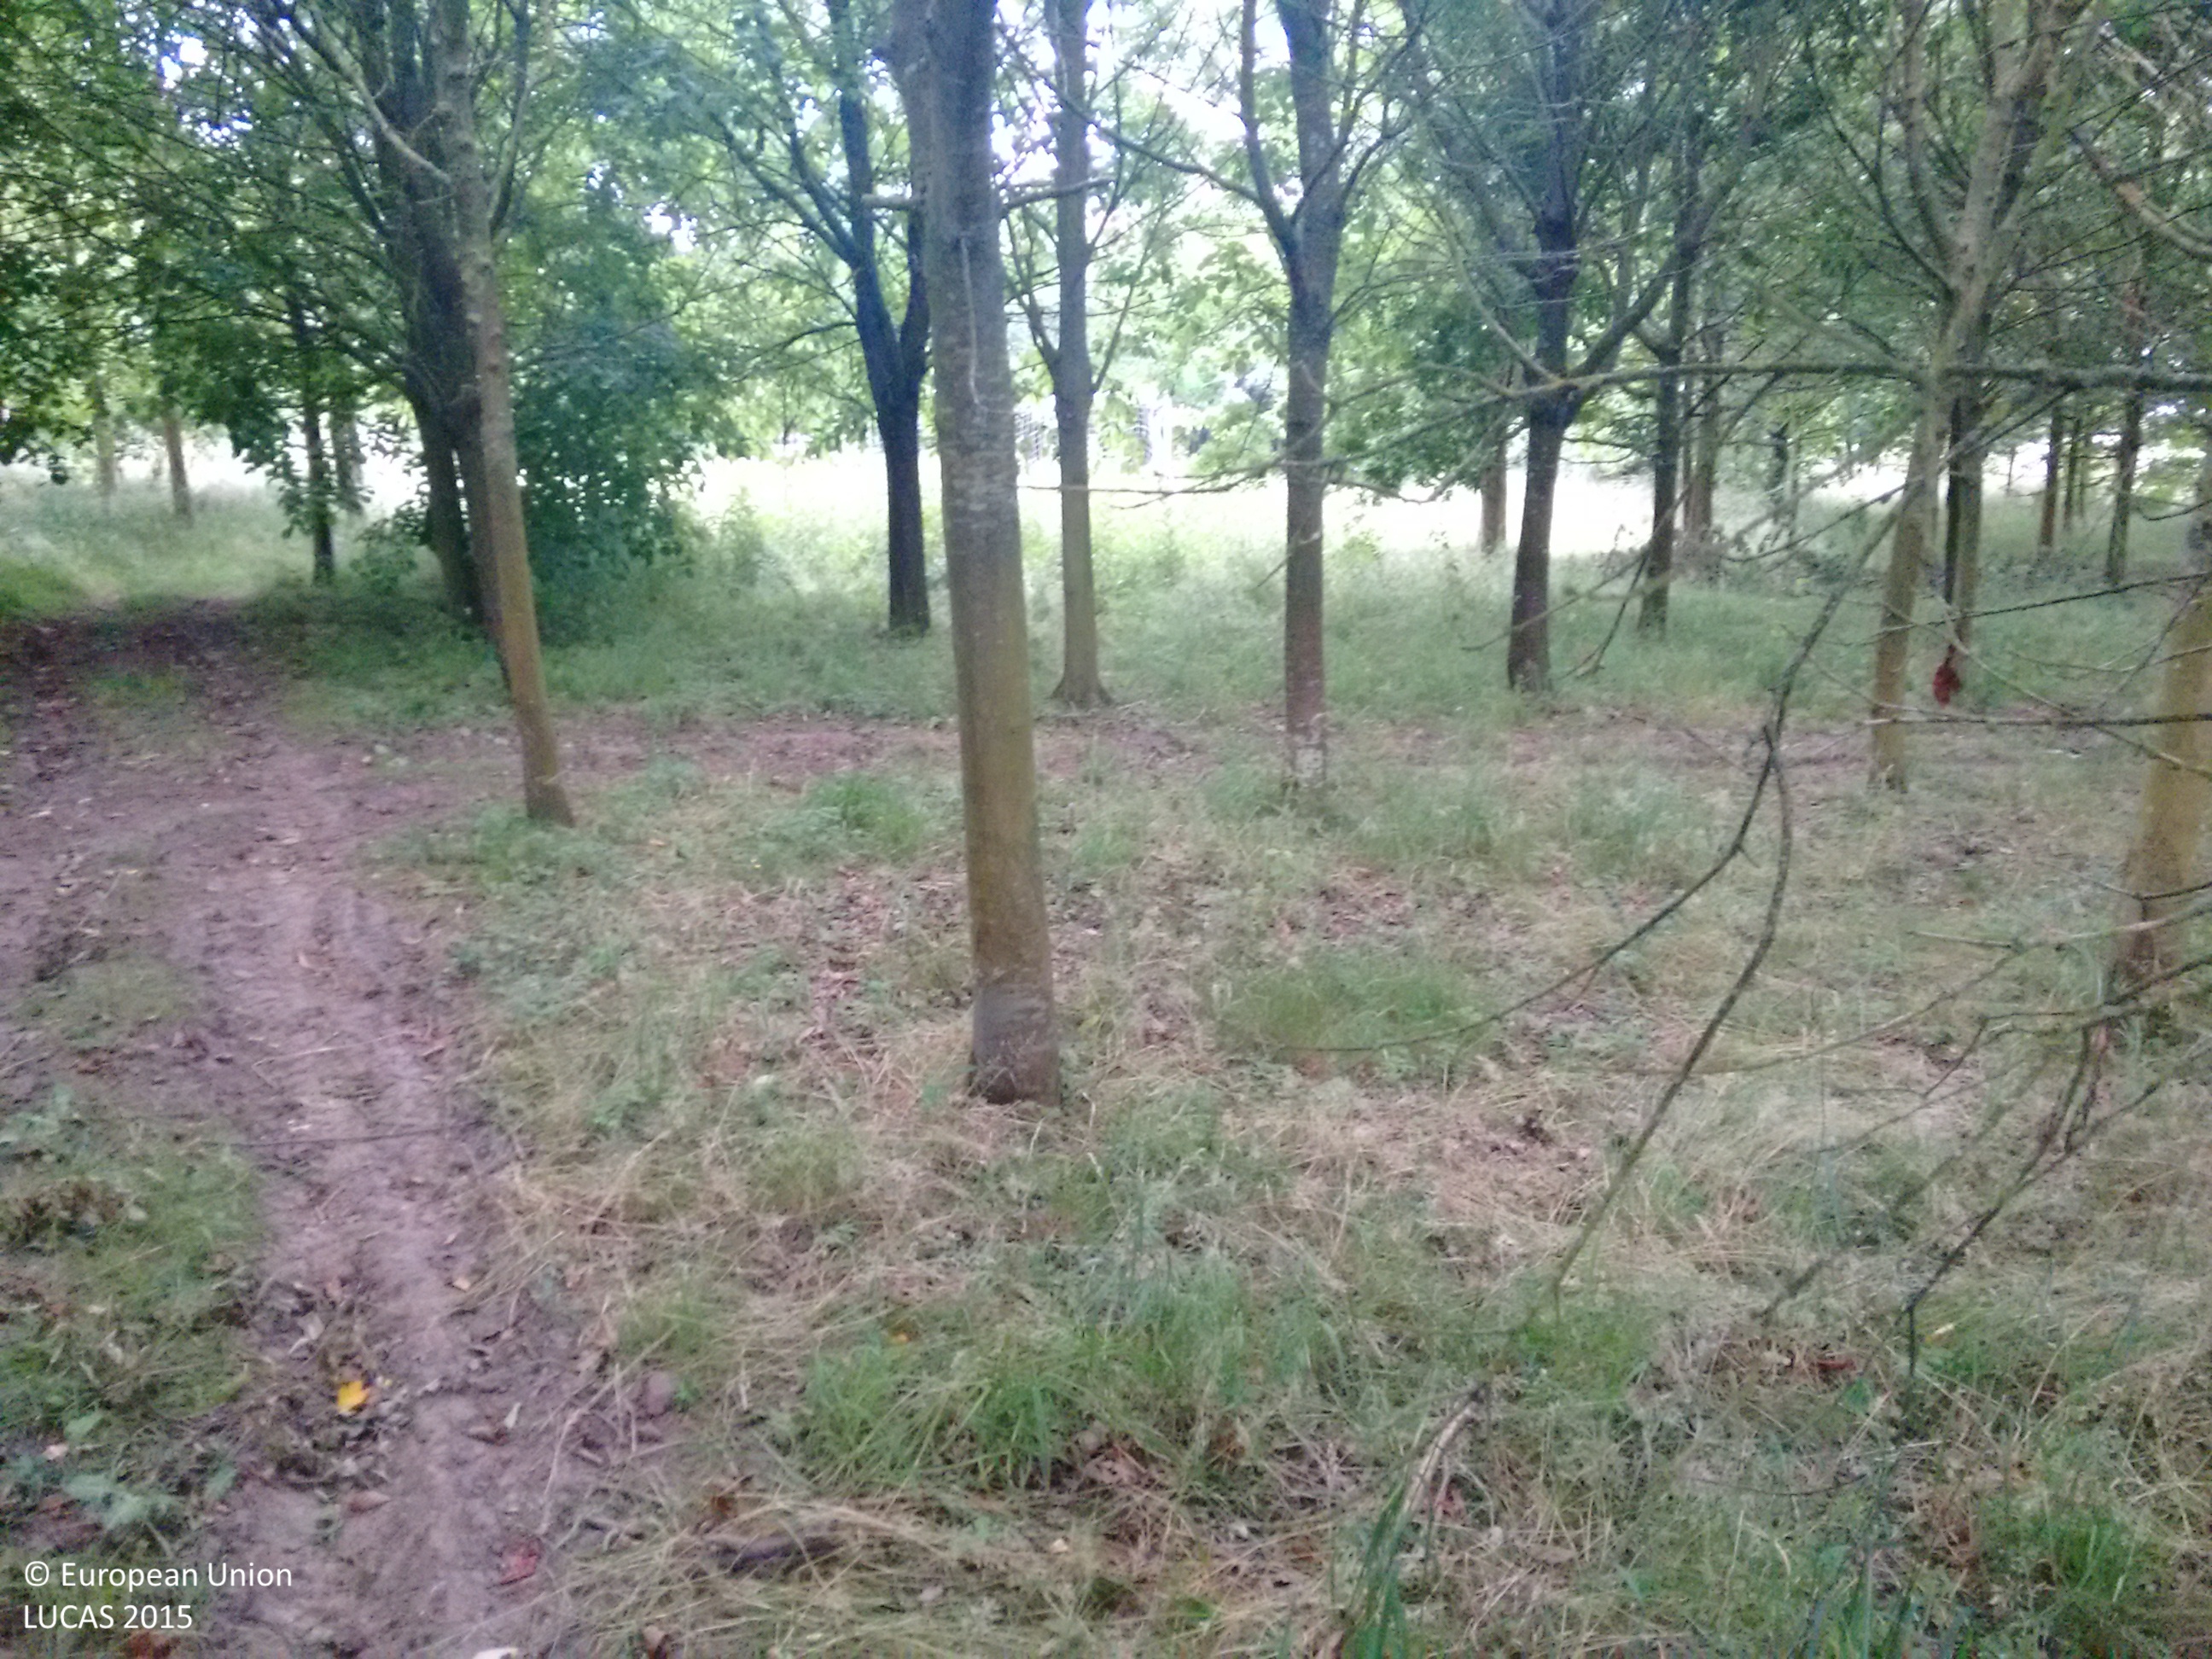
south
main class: Woodland
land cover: Broadleaved woodland
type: mesophytic deciduous forest
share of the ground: > 75 %
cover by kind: broadleaved forest trees 100 %
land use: Forestry
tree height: > 5 m
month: July
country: GB
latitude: 50.9099
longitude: -0.9233
